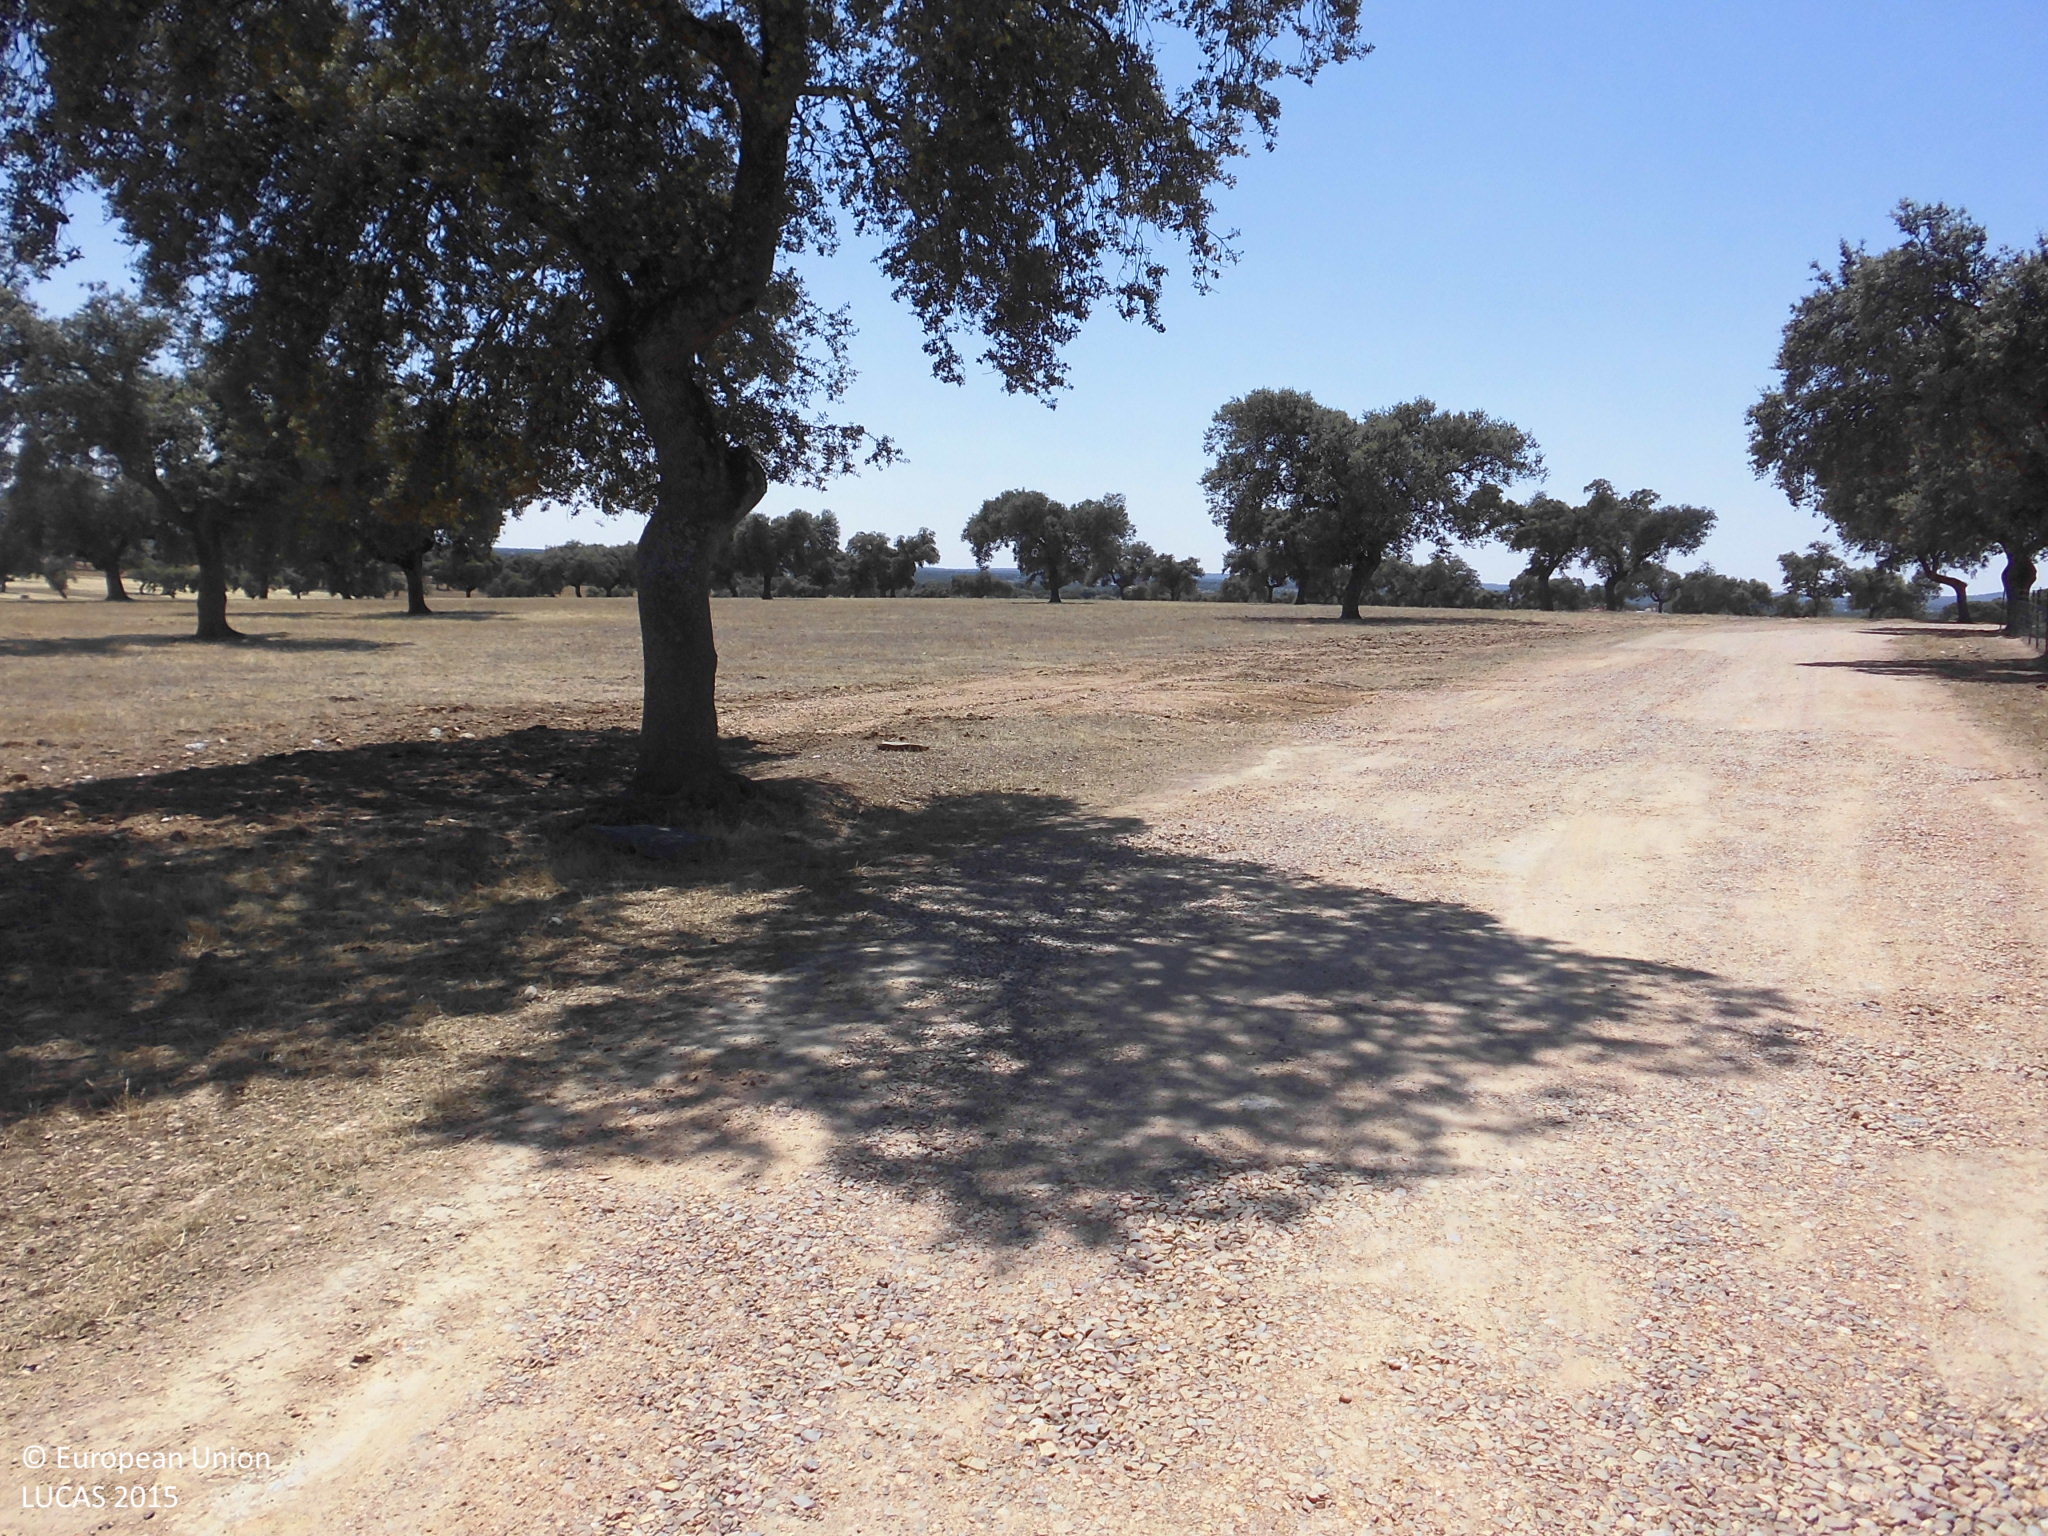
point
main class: Woodland
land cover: Broadleaved woodland
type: broadleaved evergreen forest
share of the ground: 10 - 25 %
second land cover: Grassland without tree/shrub cover
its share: > 75 %
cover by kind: herbaceous plants 80 %, broadleaved forest trees 20 %
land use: Forestry
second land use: Agriculture (excluding fallow land and kitchen gardens)
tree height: > 5 m
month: June
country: ES
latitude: 39.7334
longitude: -6.0154
